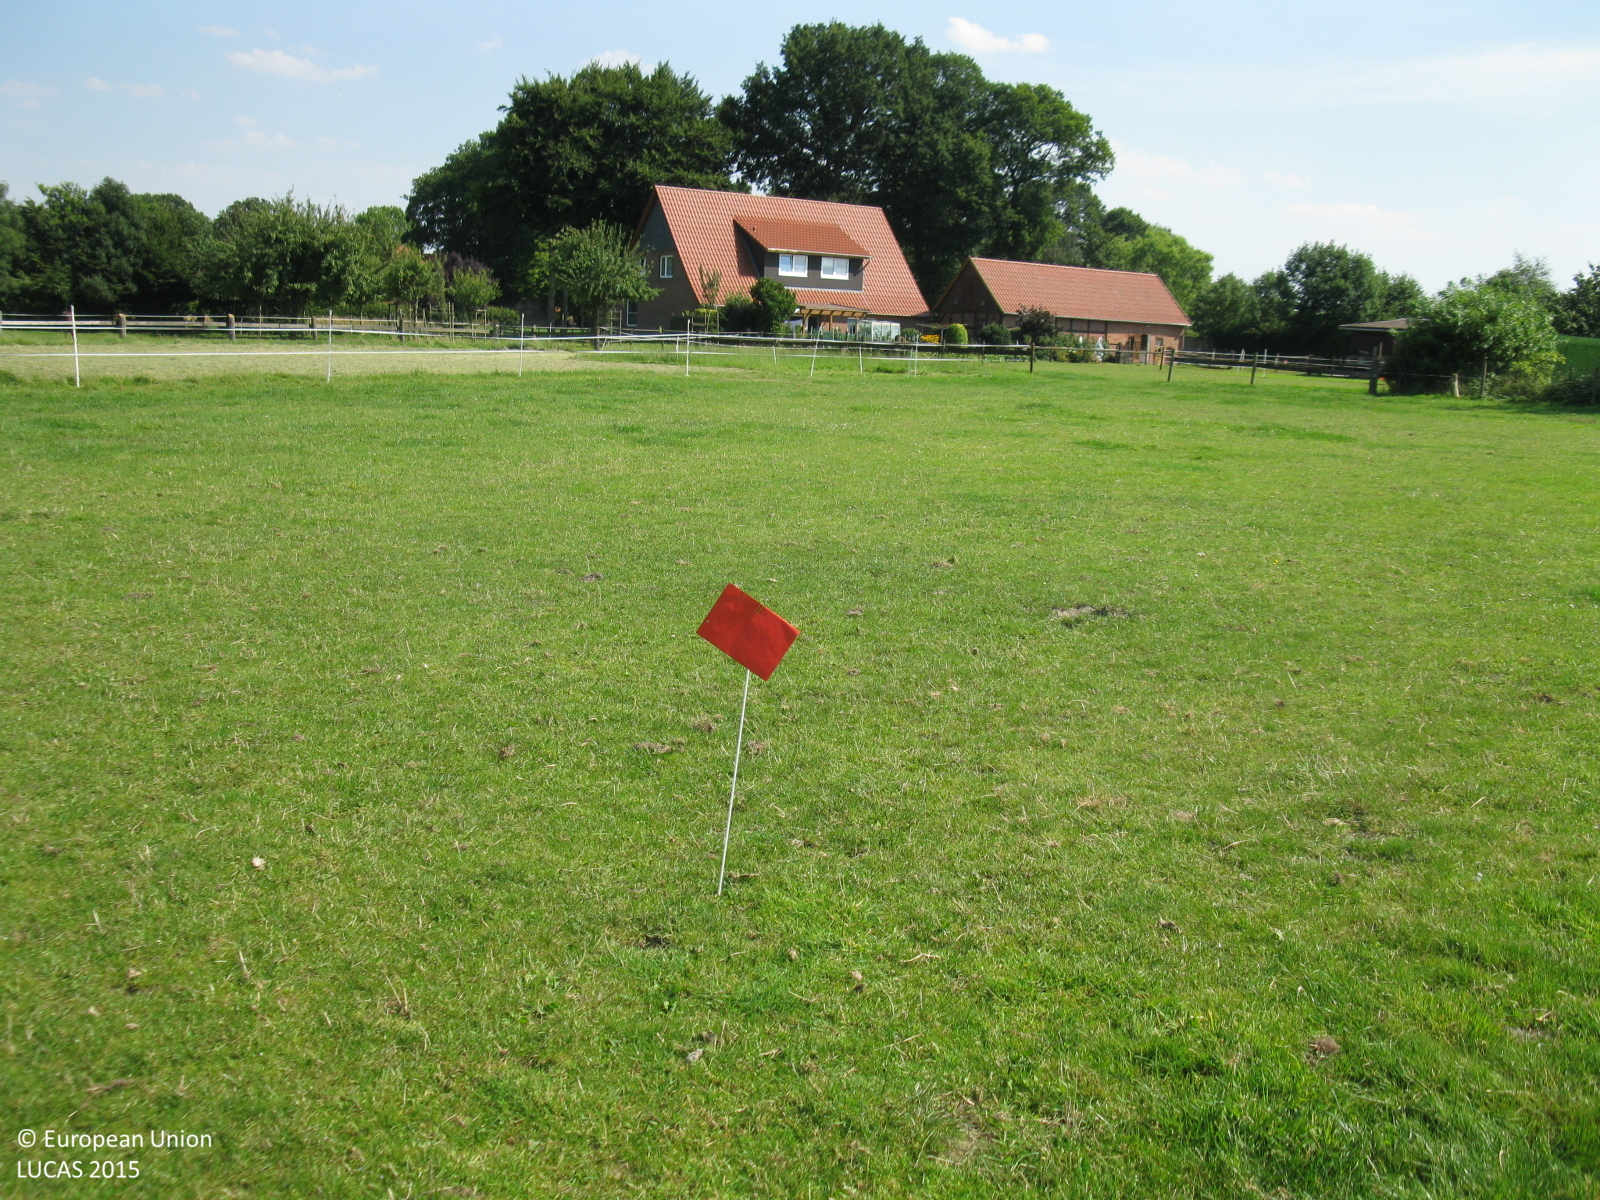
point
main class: Grassland
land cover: Grassland without tree/shrub cover
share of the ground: > 75 %
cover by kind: herbaceous plants 100 %
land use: Agriculture (excluding fallow land and kitchen gardens)
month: August
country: DE
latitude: 53.0131
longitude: 8.3461
